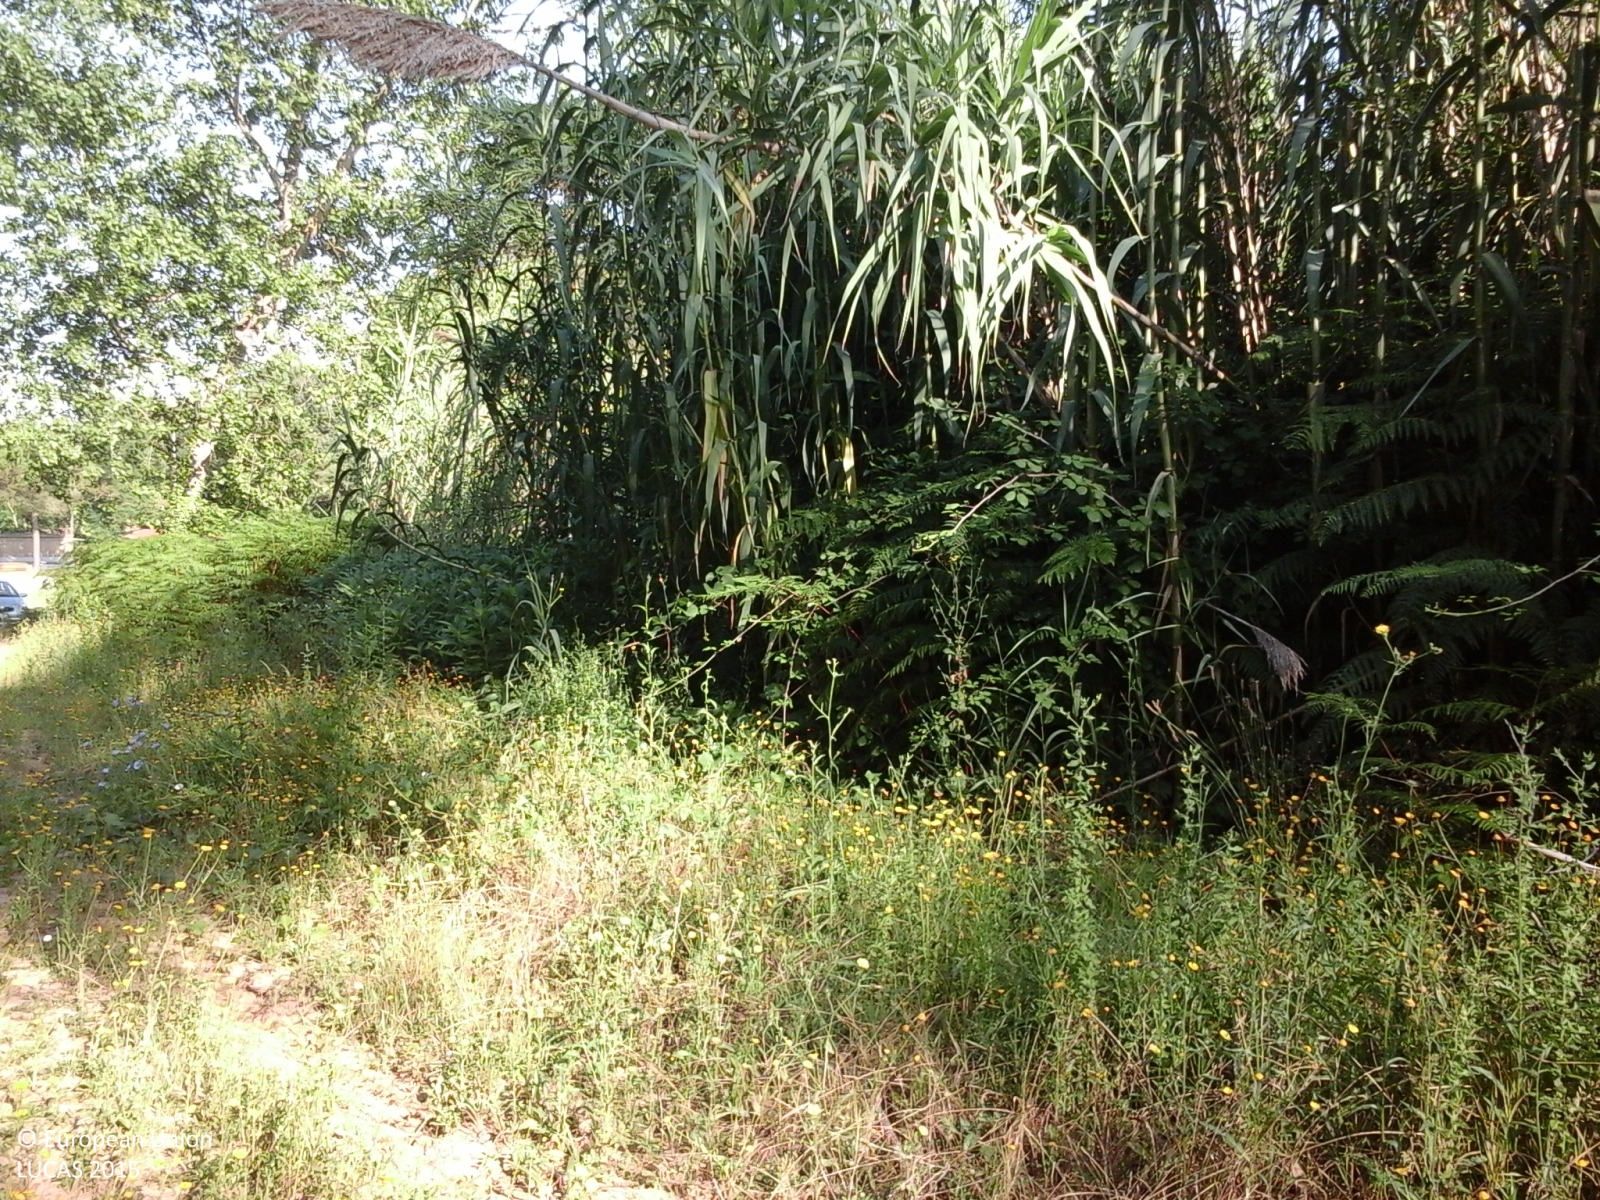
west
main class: Grassland
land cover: Grassland with sparse tree/shrub cover
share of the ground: > 75 %
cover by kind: herbaceous plants 85 %, shrubs 10 %, coniferous forest trees 5 %
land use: Agriculture (excluding fallow land and kitchen gardens)
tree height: > 5 m
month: July
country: IT
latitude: 43.3021
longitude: 10.6268
